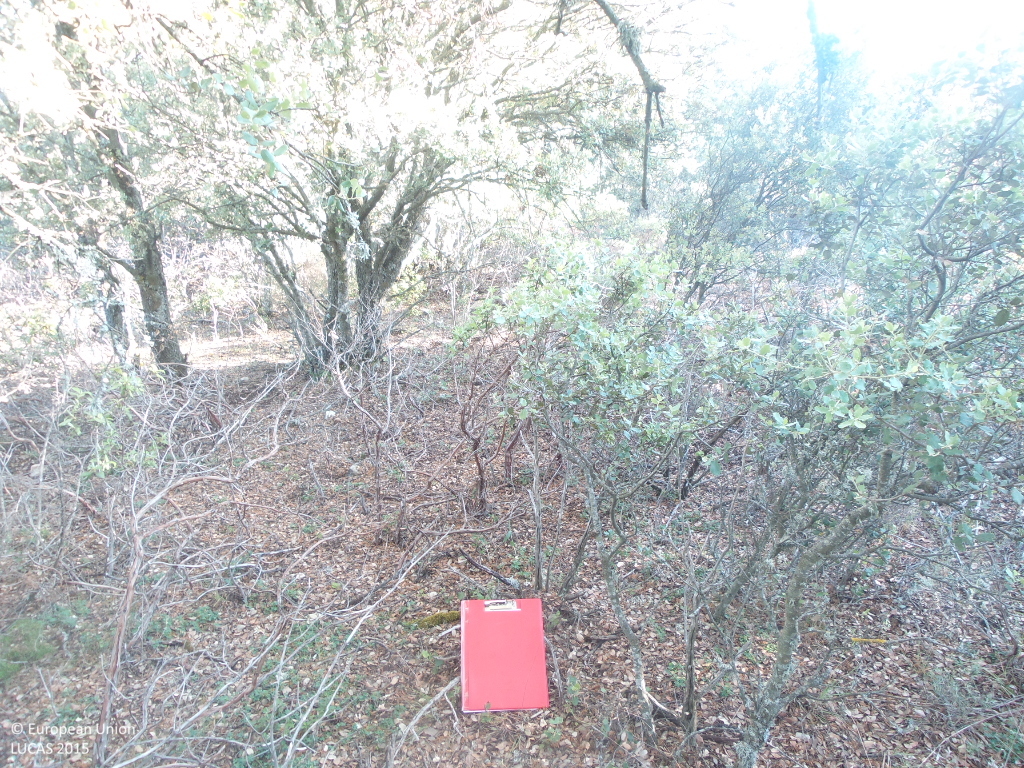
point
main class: Woodland
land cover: Broadleaved woodland
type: broadleaved evergreen forest
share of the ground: > 75 %
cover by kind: broadleaved forest trees 80 %, shrubs 10 %, herbaceous plants 5 %, unconsolidated bare surface 5 %
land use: Semi-natural and natural areas not in use
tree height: > 5 m
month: June
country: ES
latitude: 41.0373
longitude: -2.9177
